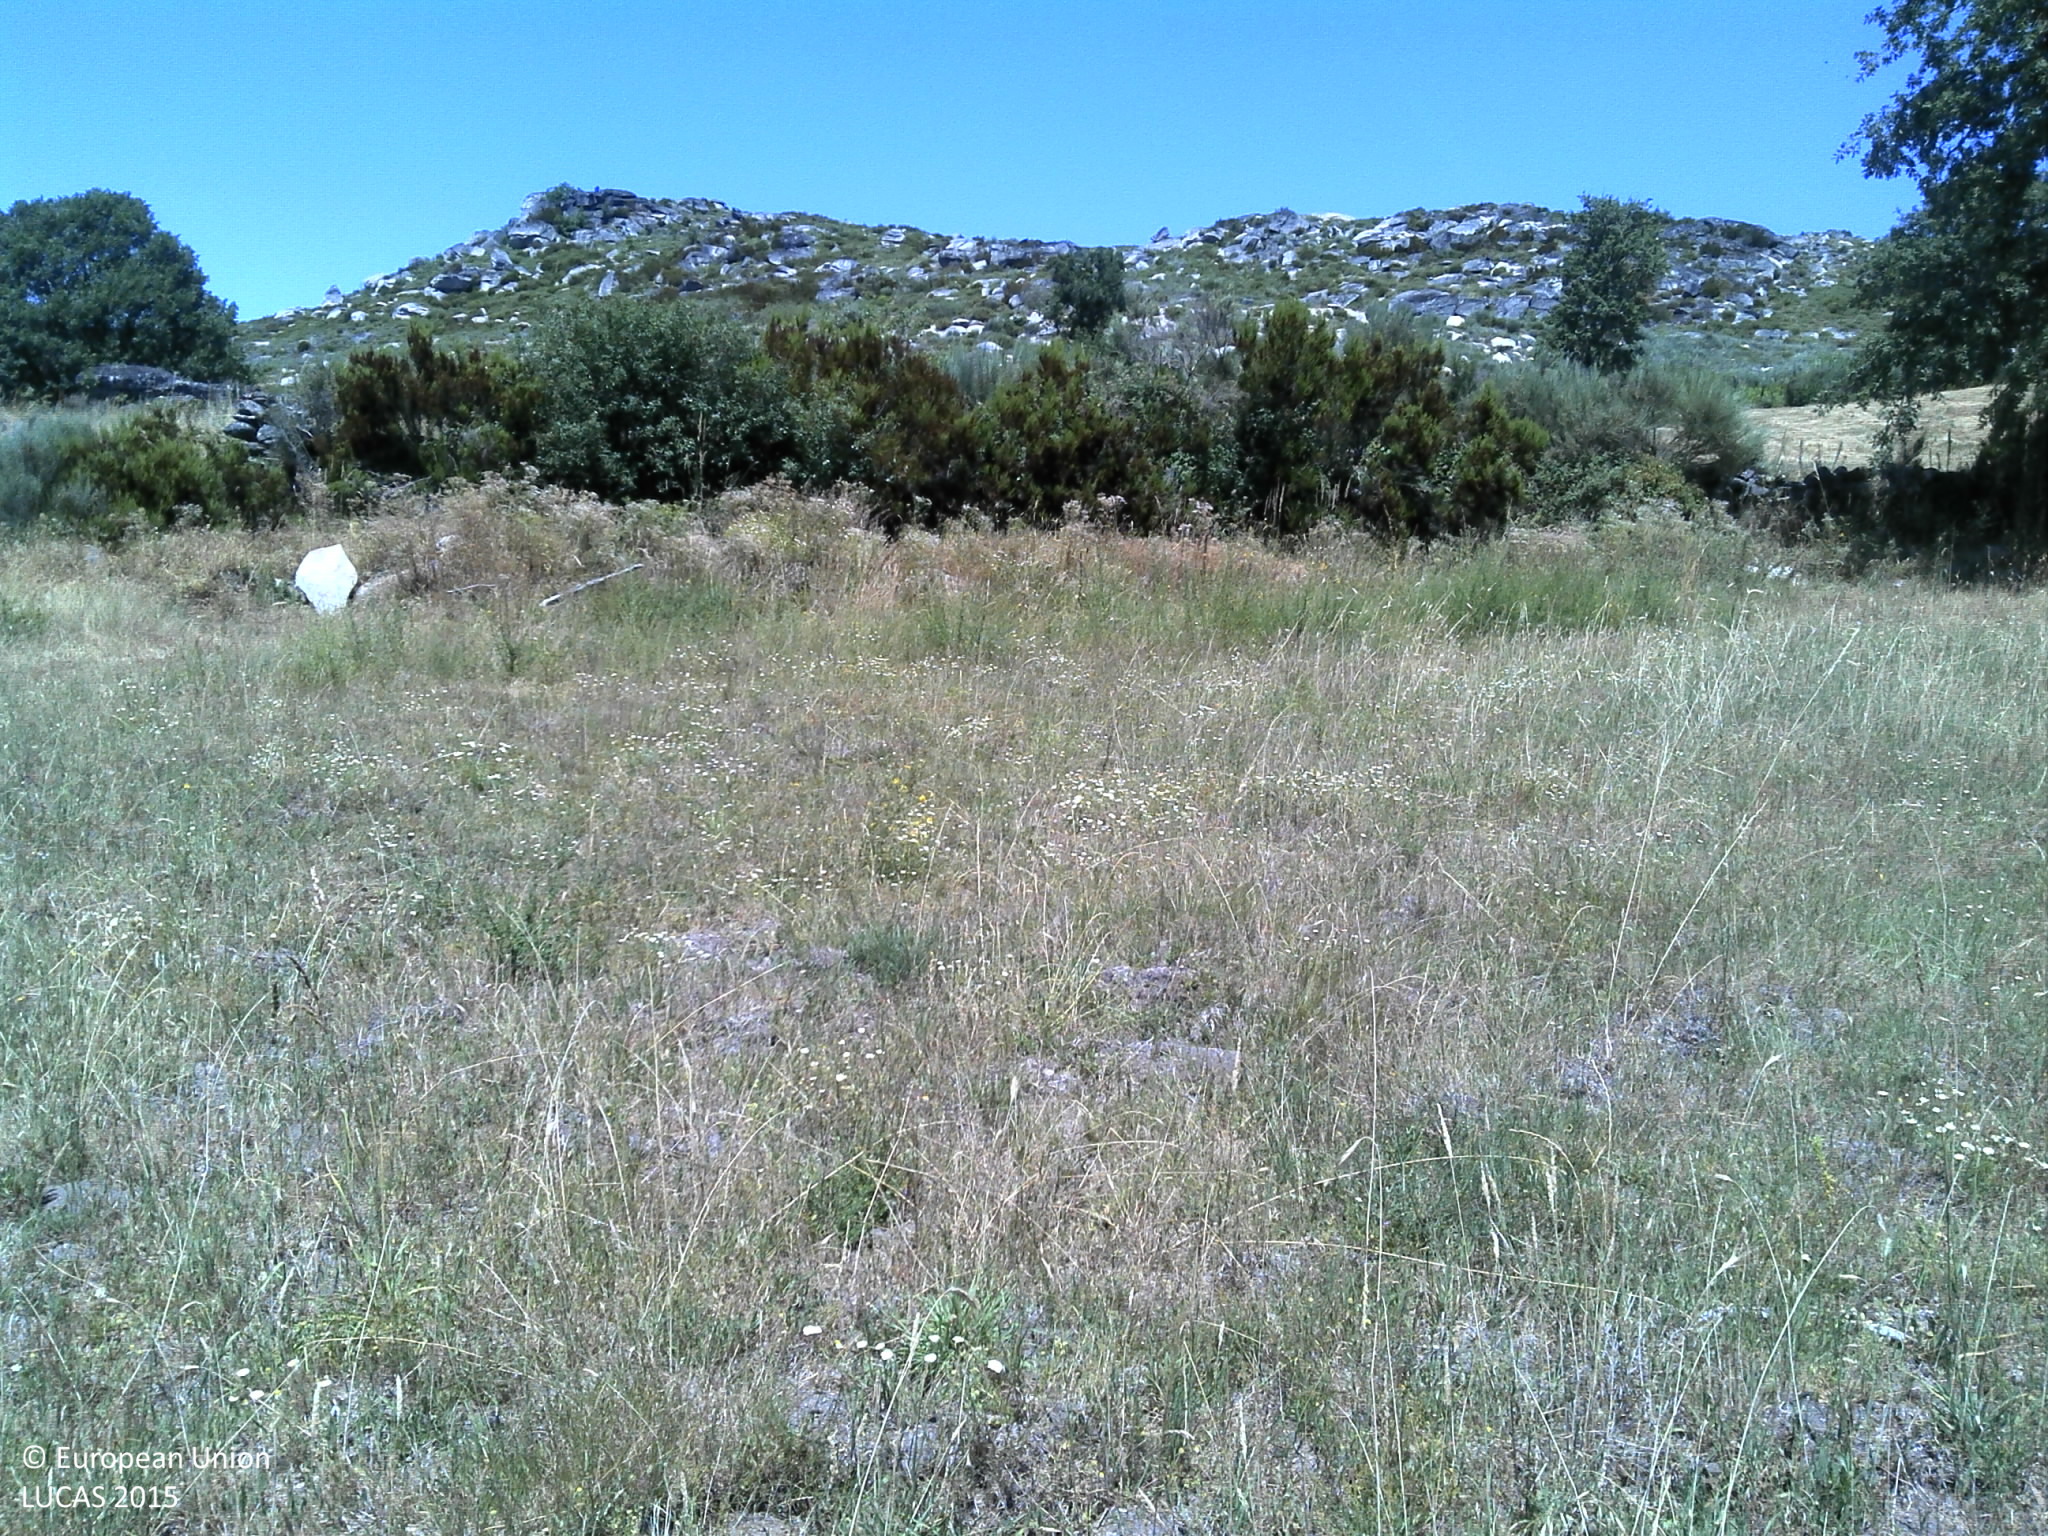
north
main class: Grassland
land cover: Grassland without tree/shrub cover
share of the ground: > 75 %
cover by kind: herbaceous plants 95 %, unconsolidated bare surface 5 %
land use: Agriculture (excluding fallow land and kitchen gardens)
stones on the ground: < 10 %
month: July
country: PT
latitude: 41.8089
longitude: -7.6496
